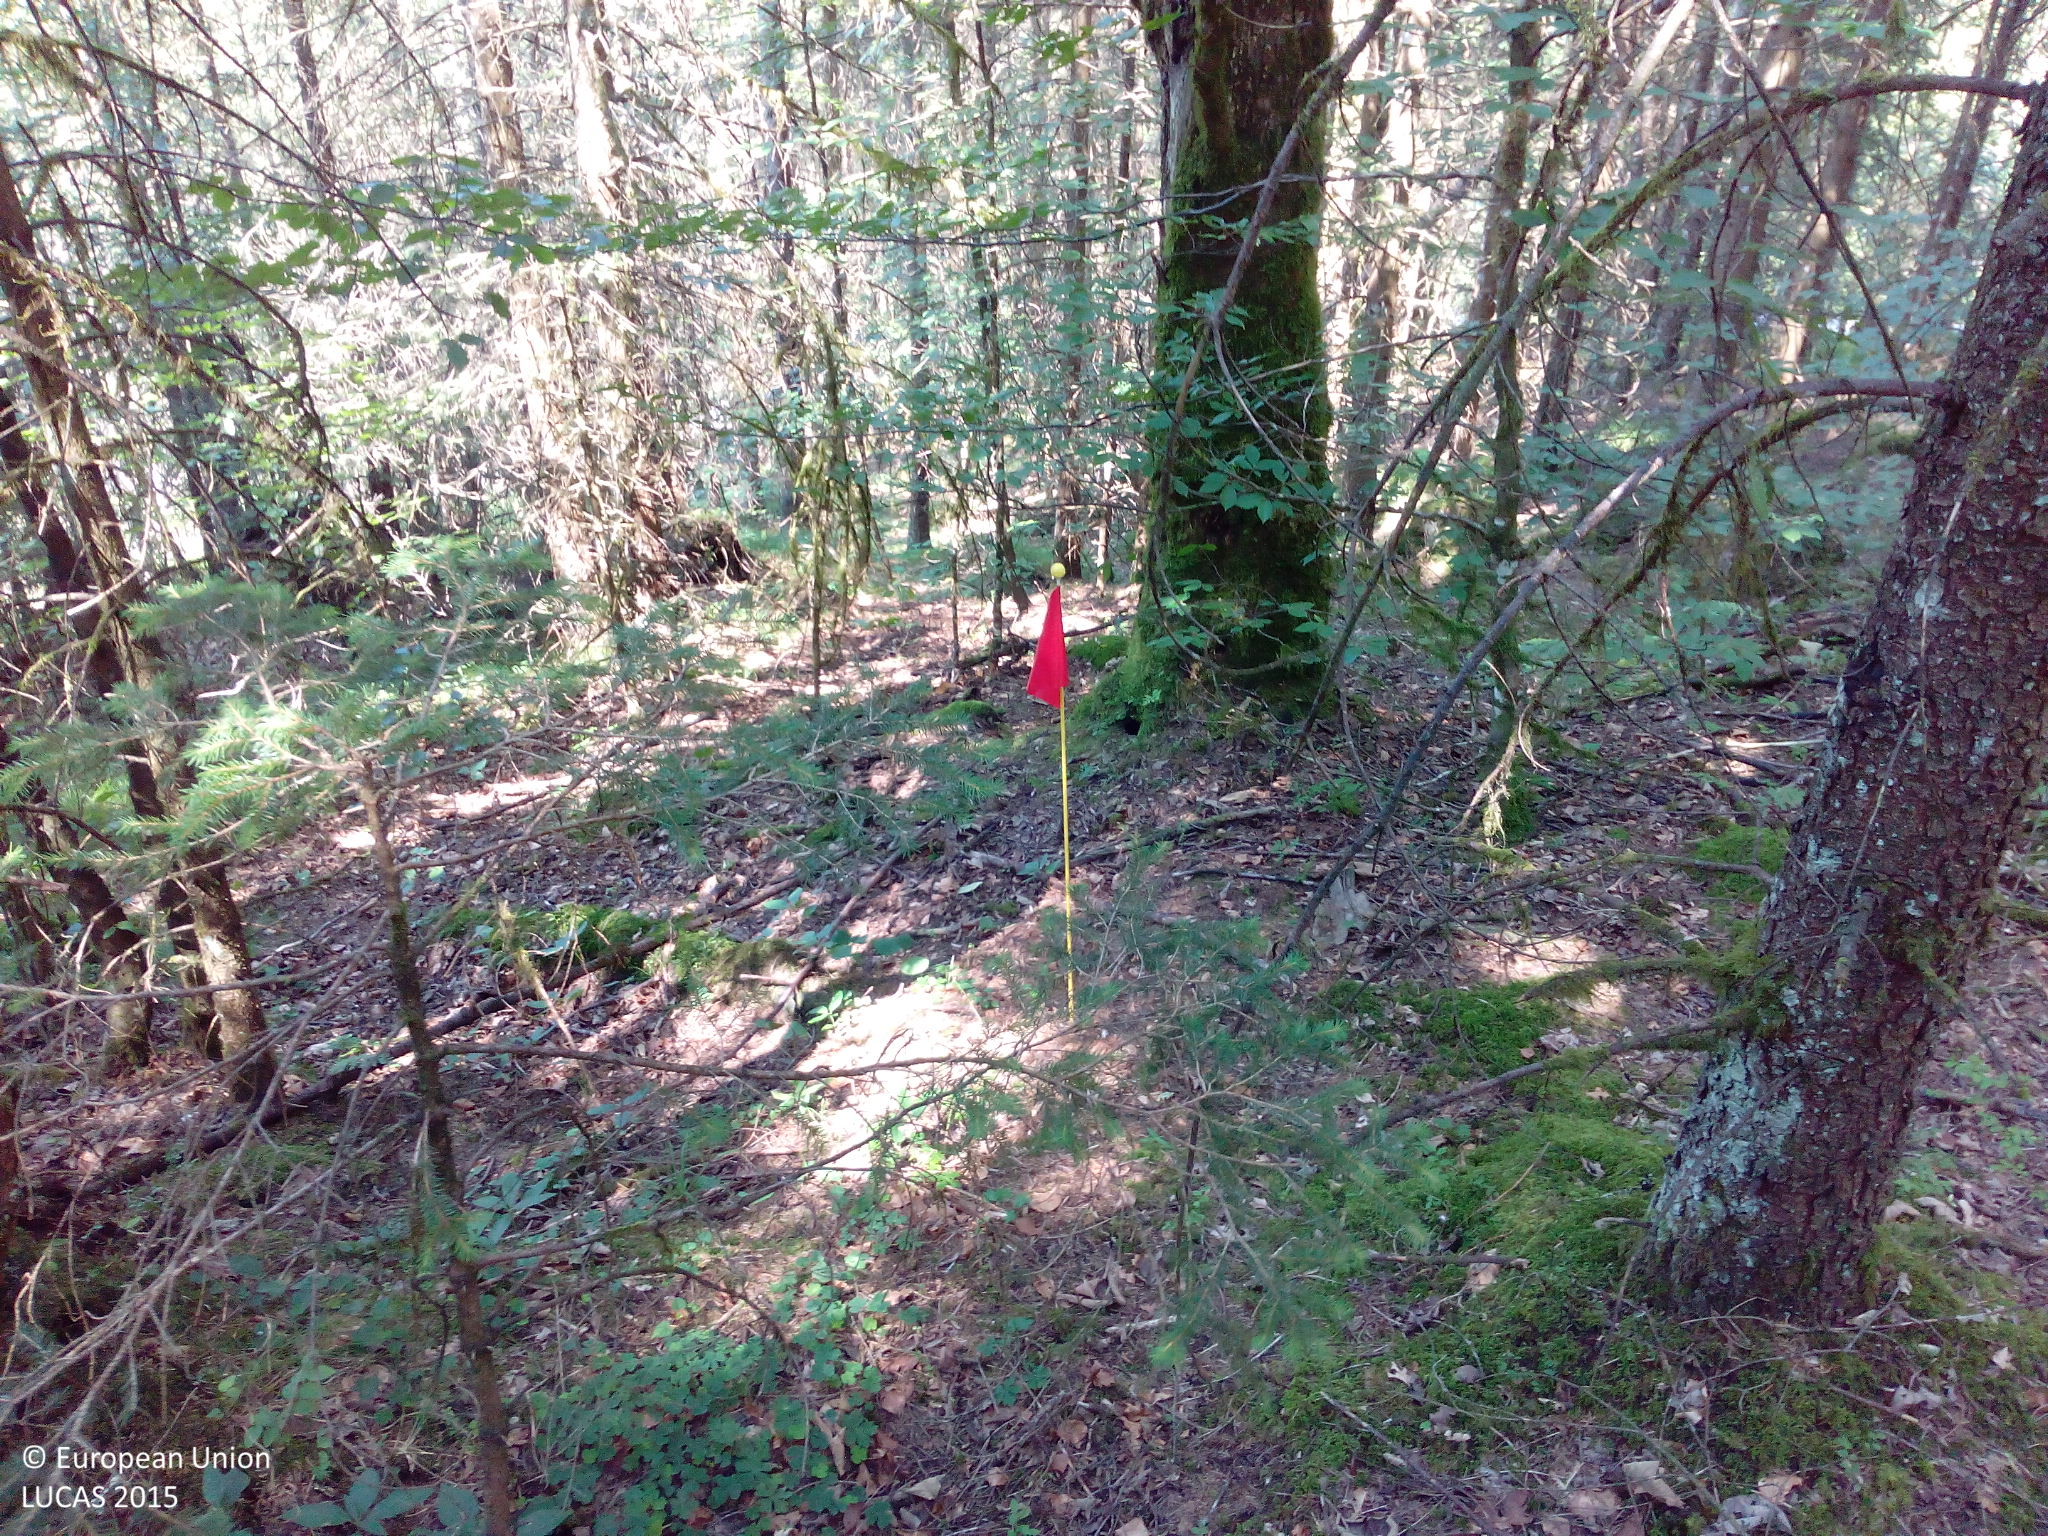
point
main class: Woodland
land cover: Spruce dominated coniferous woodland
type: hemiboreal forest and nemoral coniferous forest and mixed broadleaved-coniferous forest
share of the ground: > 75 %
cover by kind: coniferous forest trees 90 %, broadleaved forest trees 10 %
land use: Forestry
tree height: > 5 m
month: August
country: DE
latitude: 47.5674
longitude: 11.3414
